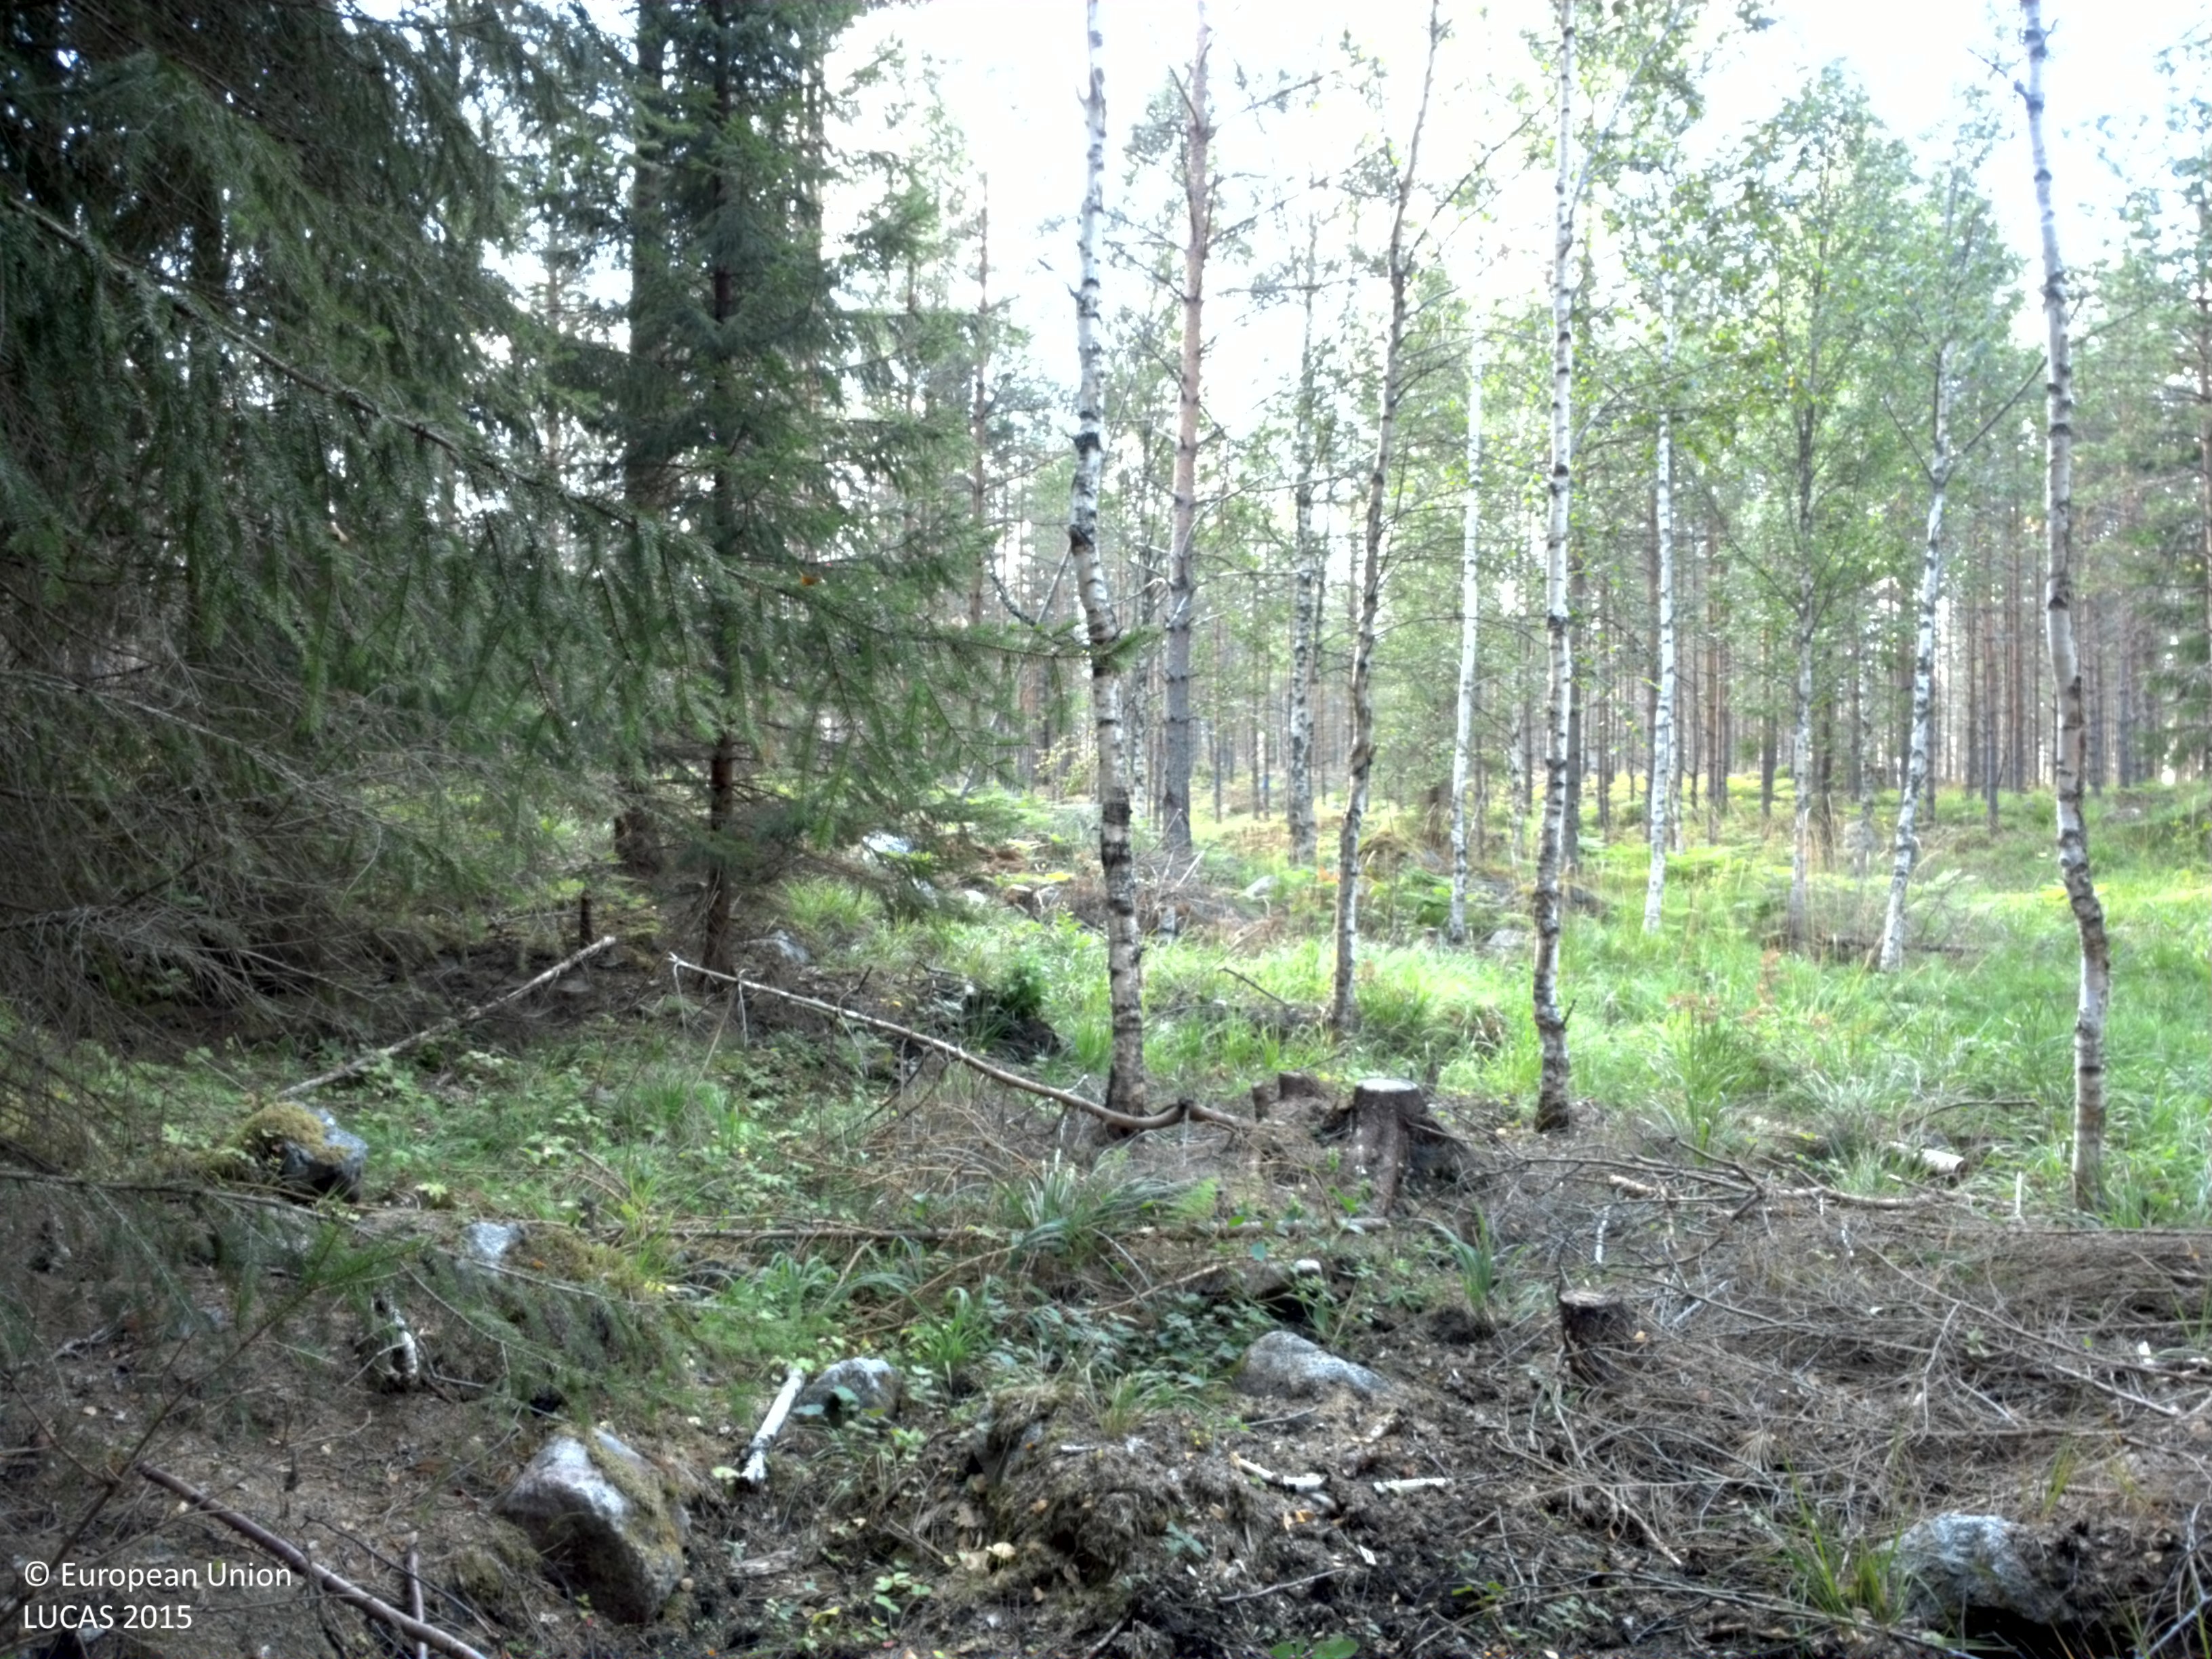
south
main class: Woodland
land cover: Spruce dominated mixed woodland
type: boreal forest
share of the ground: > 75 %
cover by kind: coniferous forest trees 60 %, broadleaved forest trees 20 %, lichens and mosses 20 %
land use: Forestry
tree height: > 5 m
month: August
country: SE
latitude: 60.1084
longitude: 17.8191
